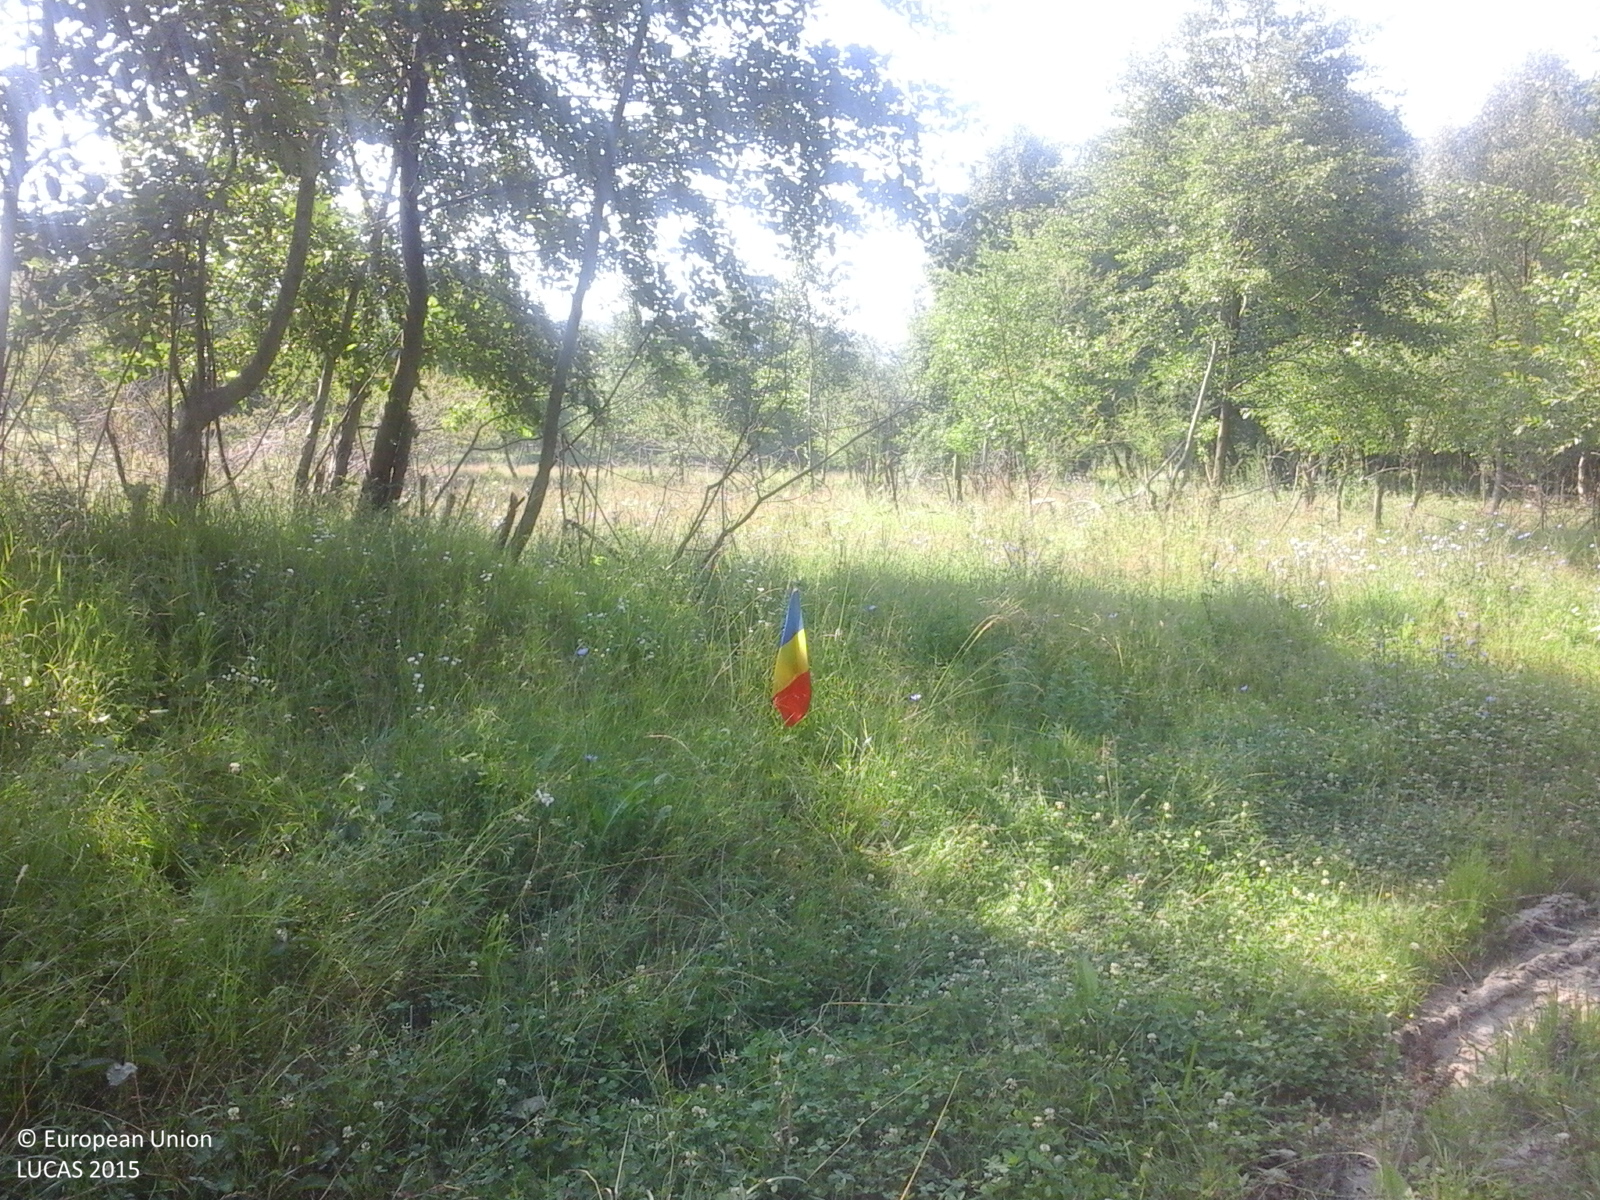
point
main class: Woodland
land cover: Broadleaved woodland
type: beech forest
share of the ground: > 75 %
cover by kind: broadleaved forest trees 100 %
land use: Forestry
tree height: > 5 m
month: July
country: RO
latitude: 45.1245
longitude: 25.1034
